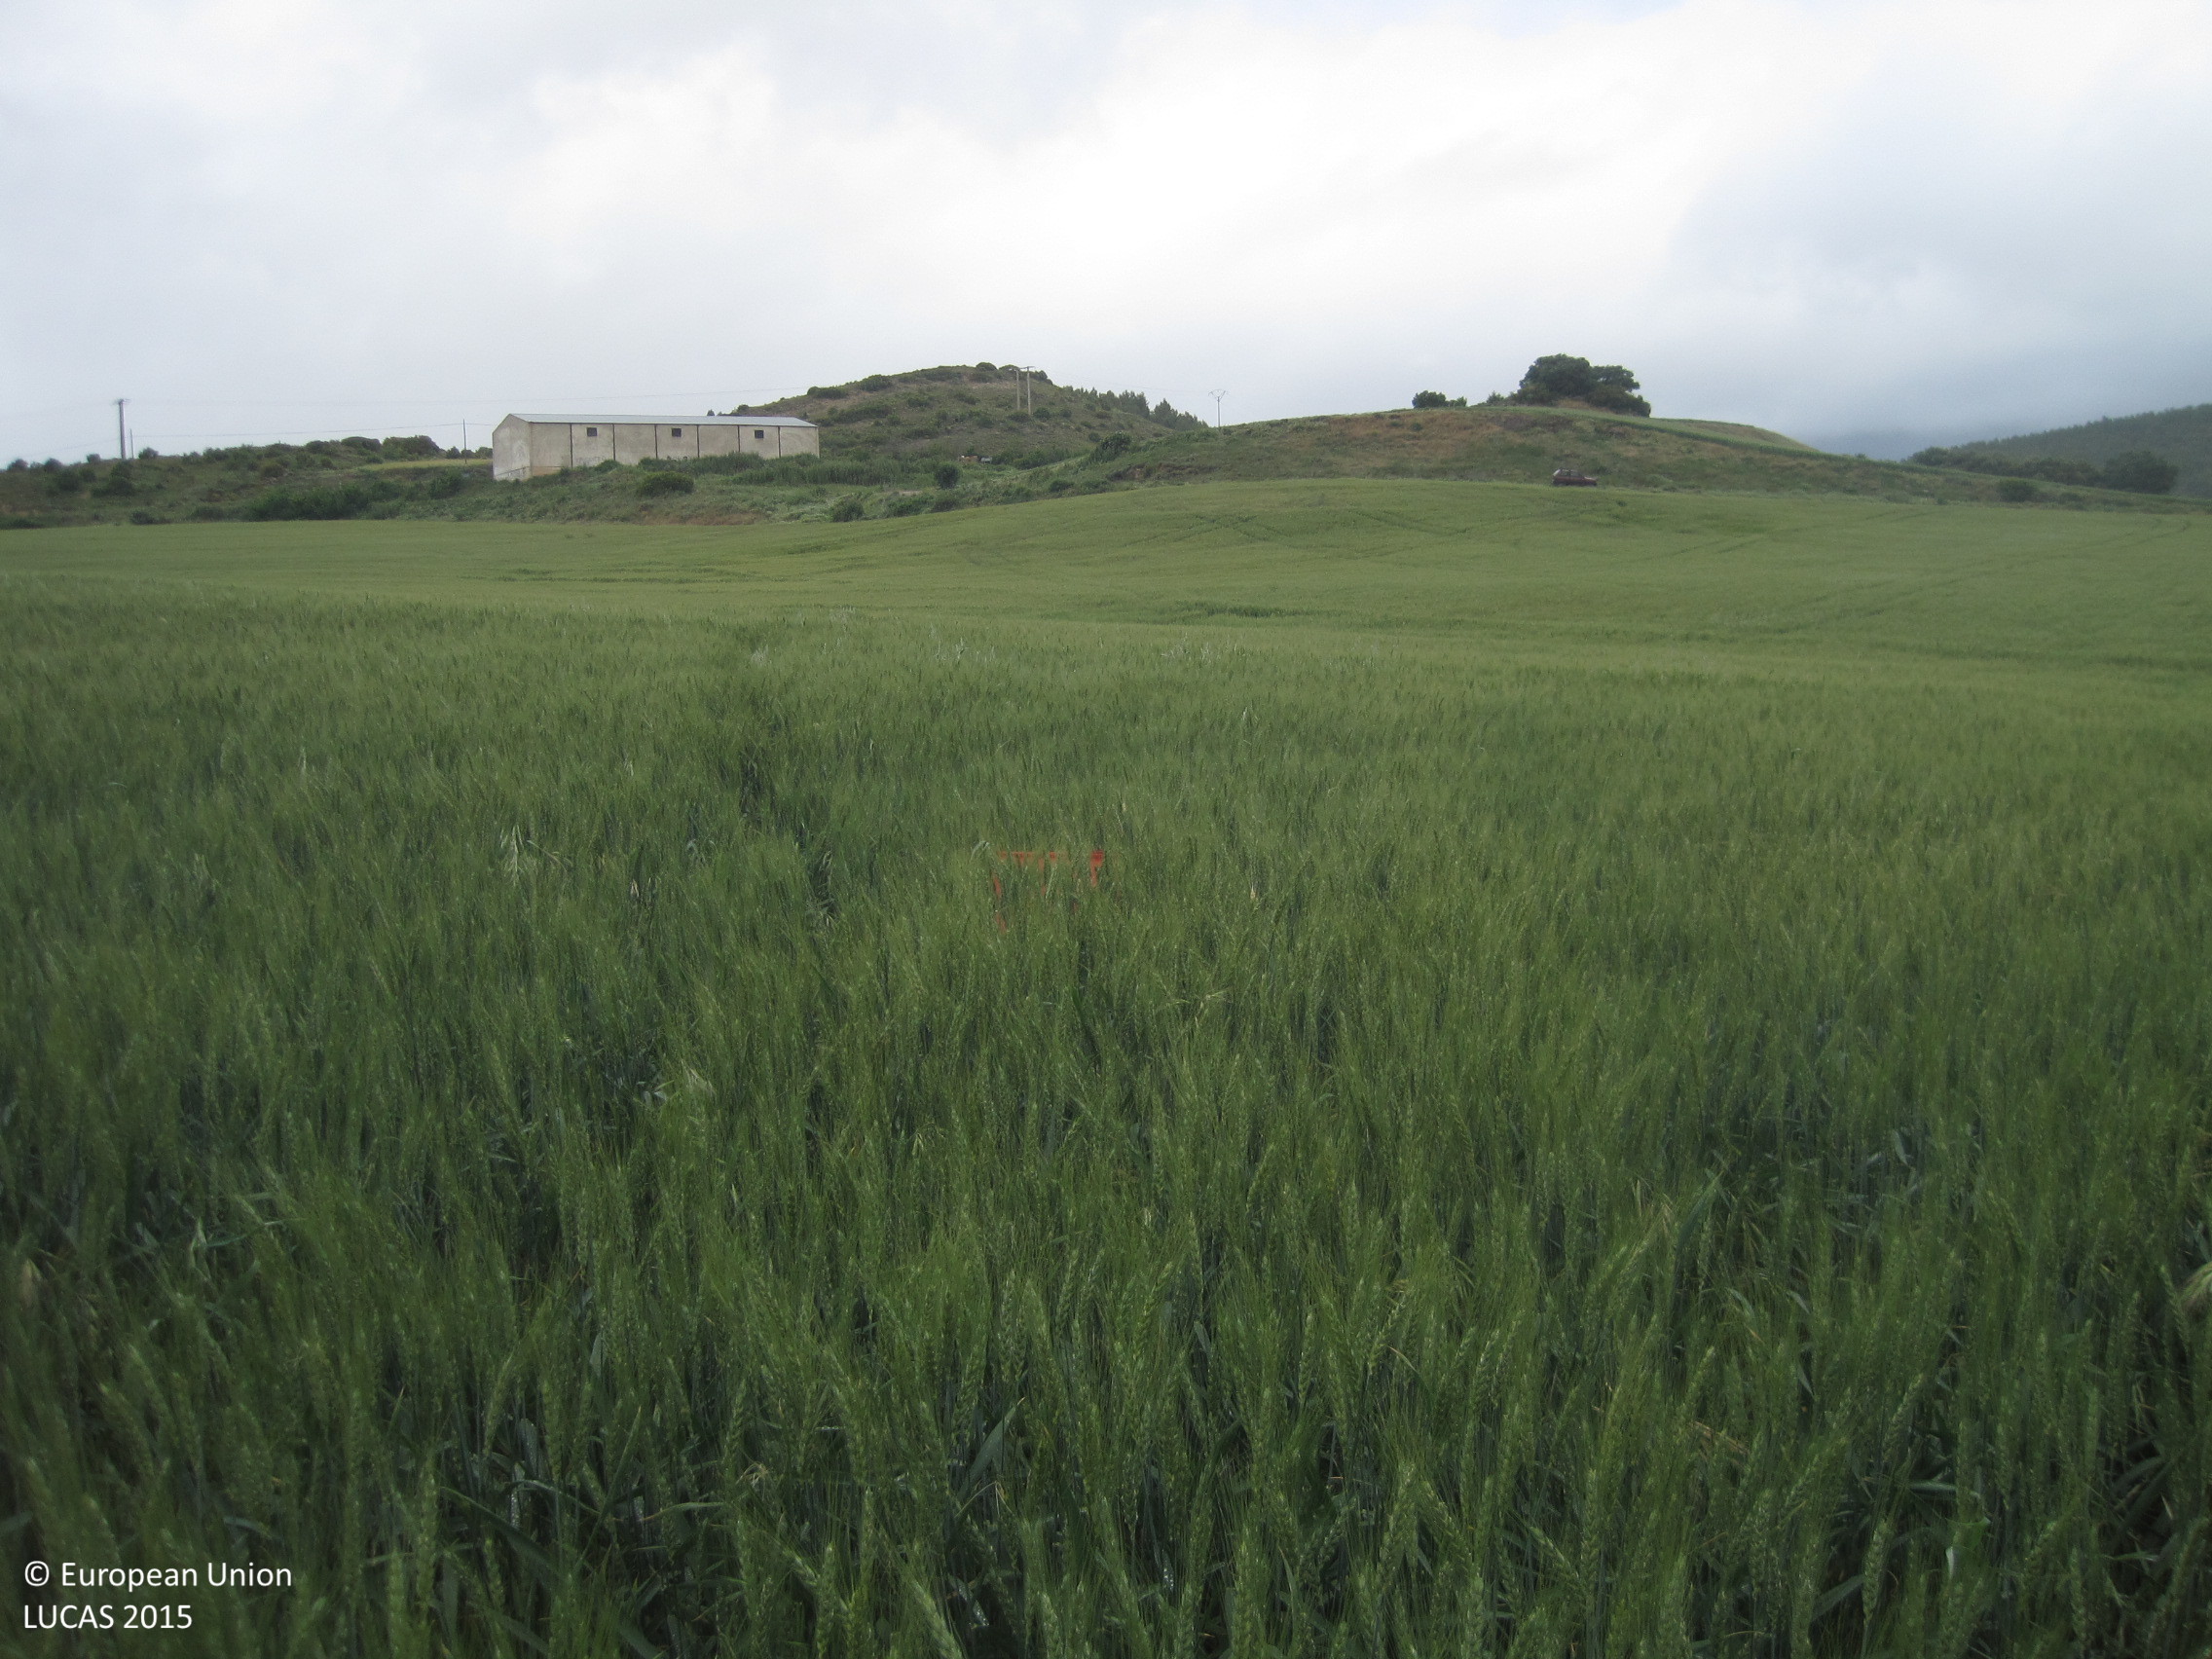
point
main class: Cropland
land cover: Durum wheat
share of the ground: > 75 %
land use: Agriculture (excluding fallow land and kitchen gardens)
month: May
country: ES
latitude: 42.5740
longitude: -1.2290
